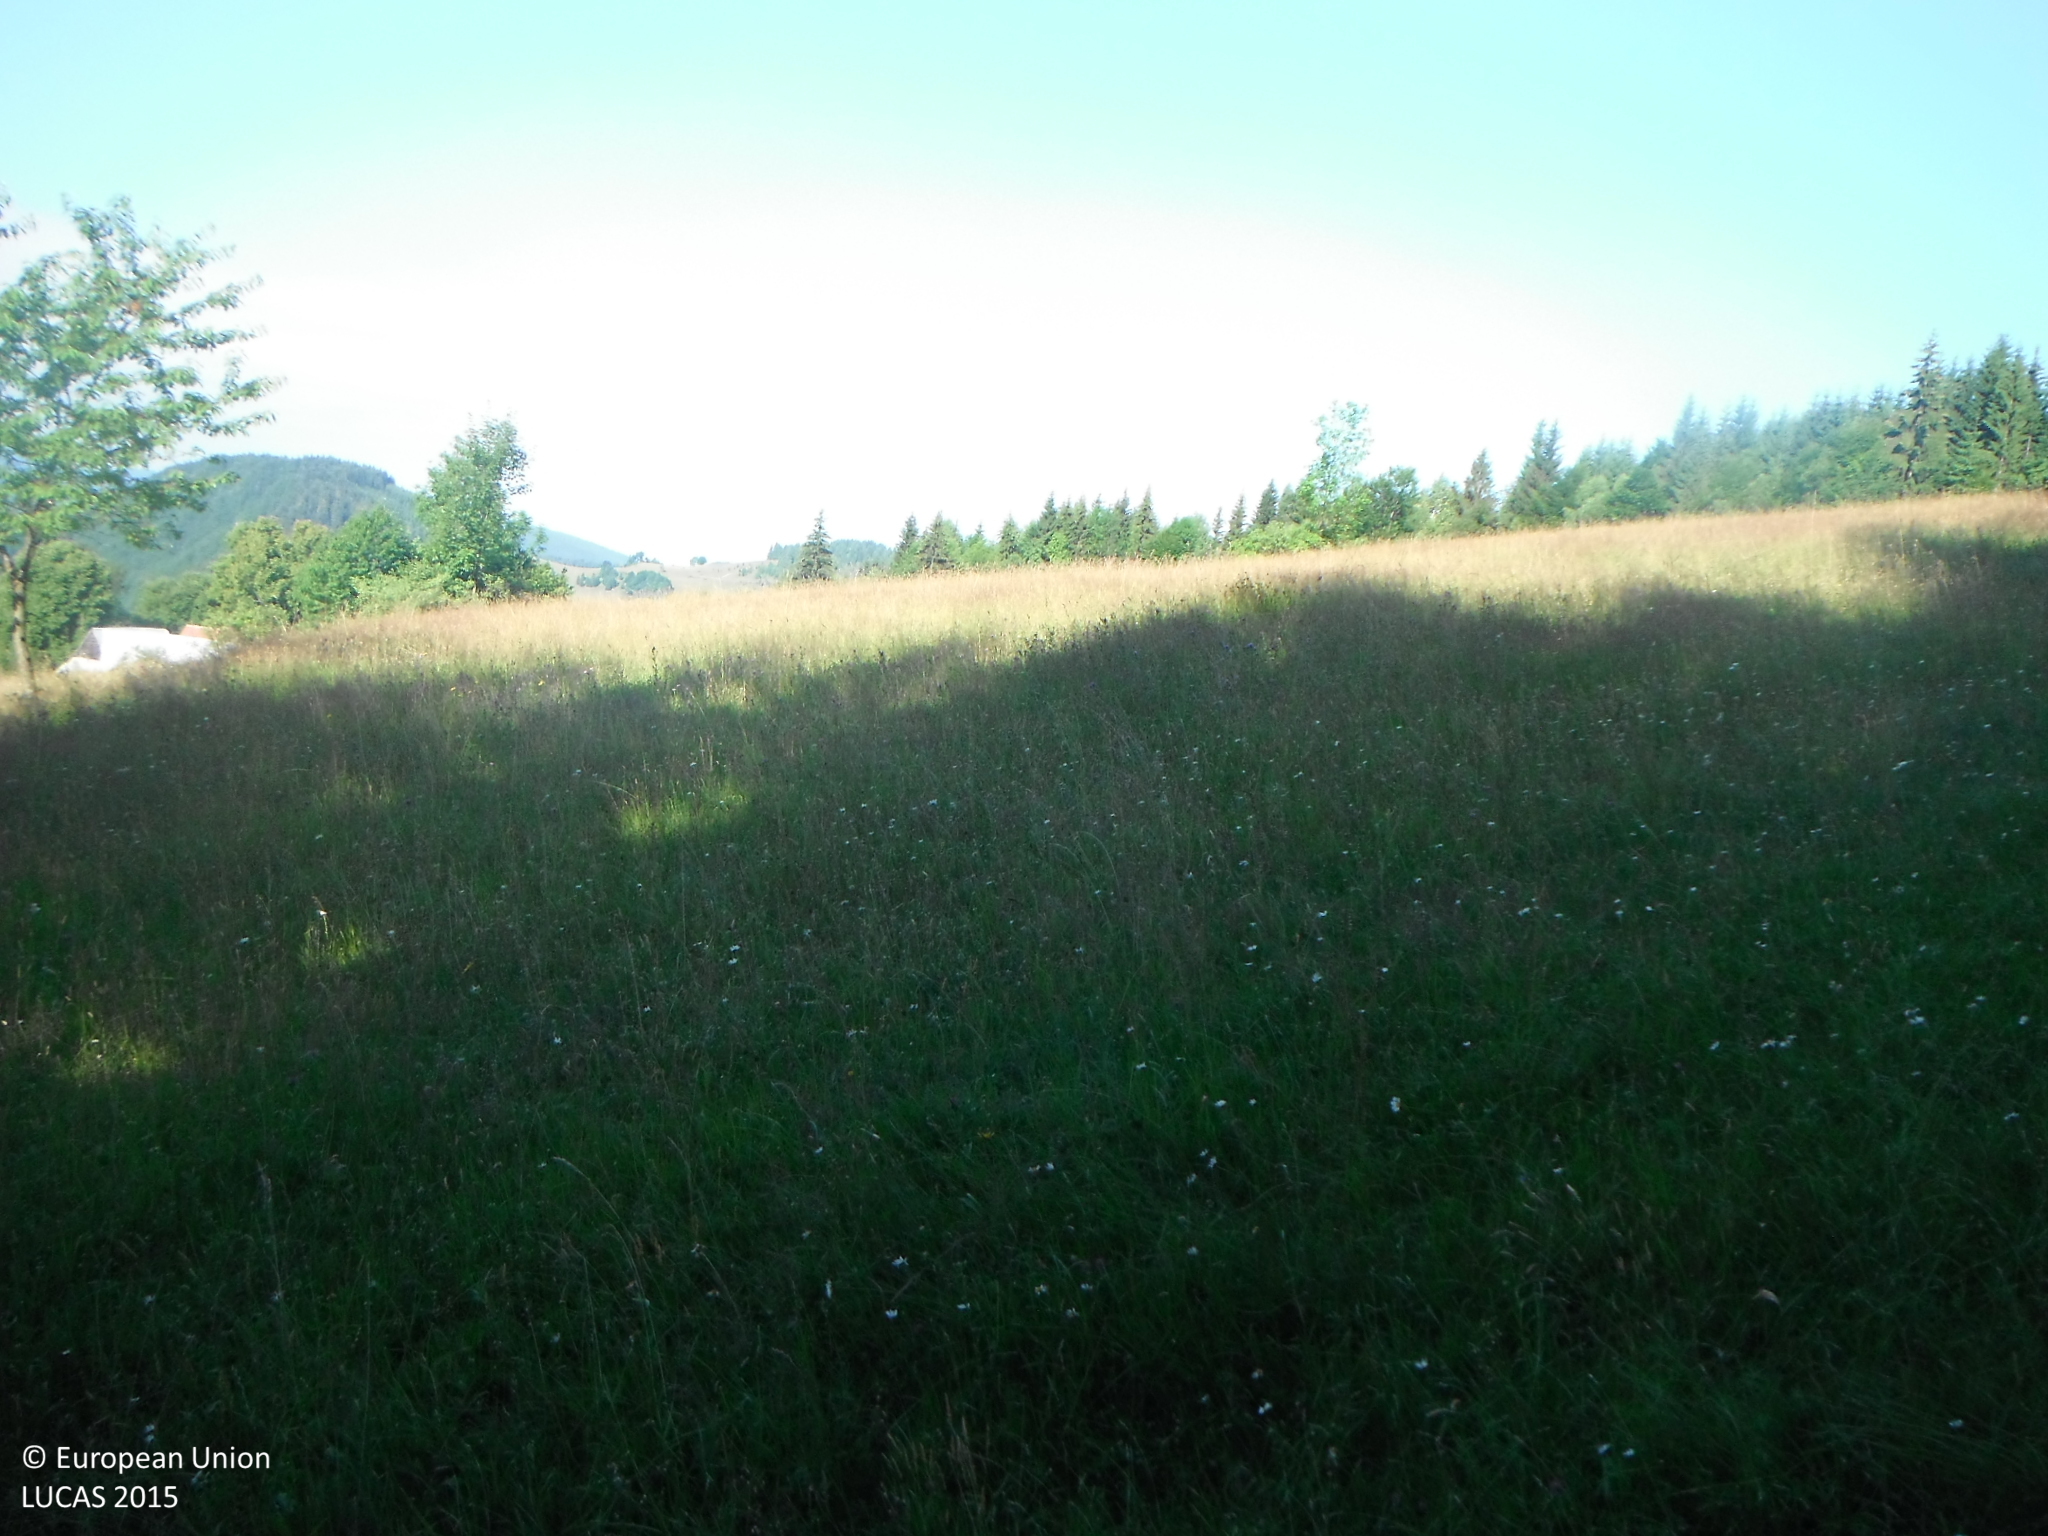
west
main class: Woodland
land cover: Spruce dominated coniferous woodland
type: alpine coniferous forest
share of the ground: > 75 %
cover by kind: coniferous forest trees 95 %, broadleaved forest trees 5 %
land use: Forestry
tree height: > 5 m
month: July
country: SK
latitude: 49.3050
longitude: 19.1971
